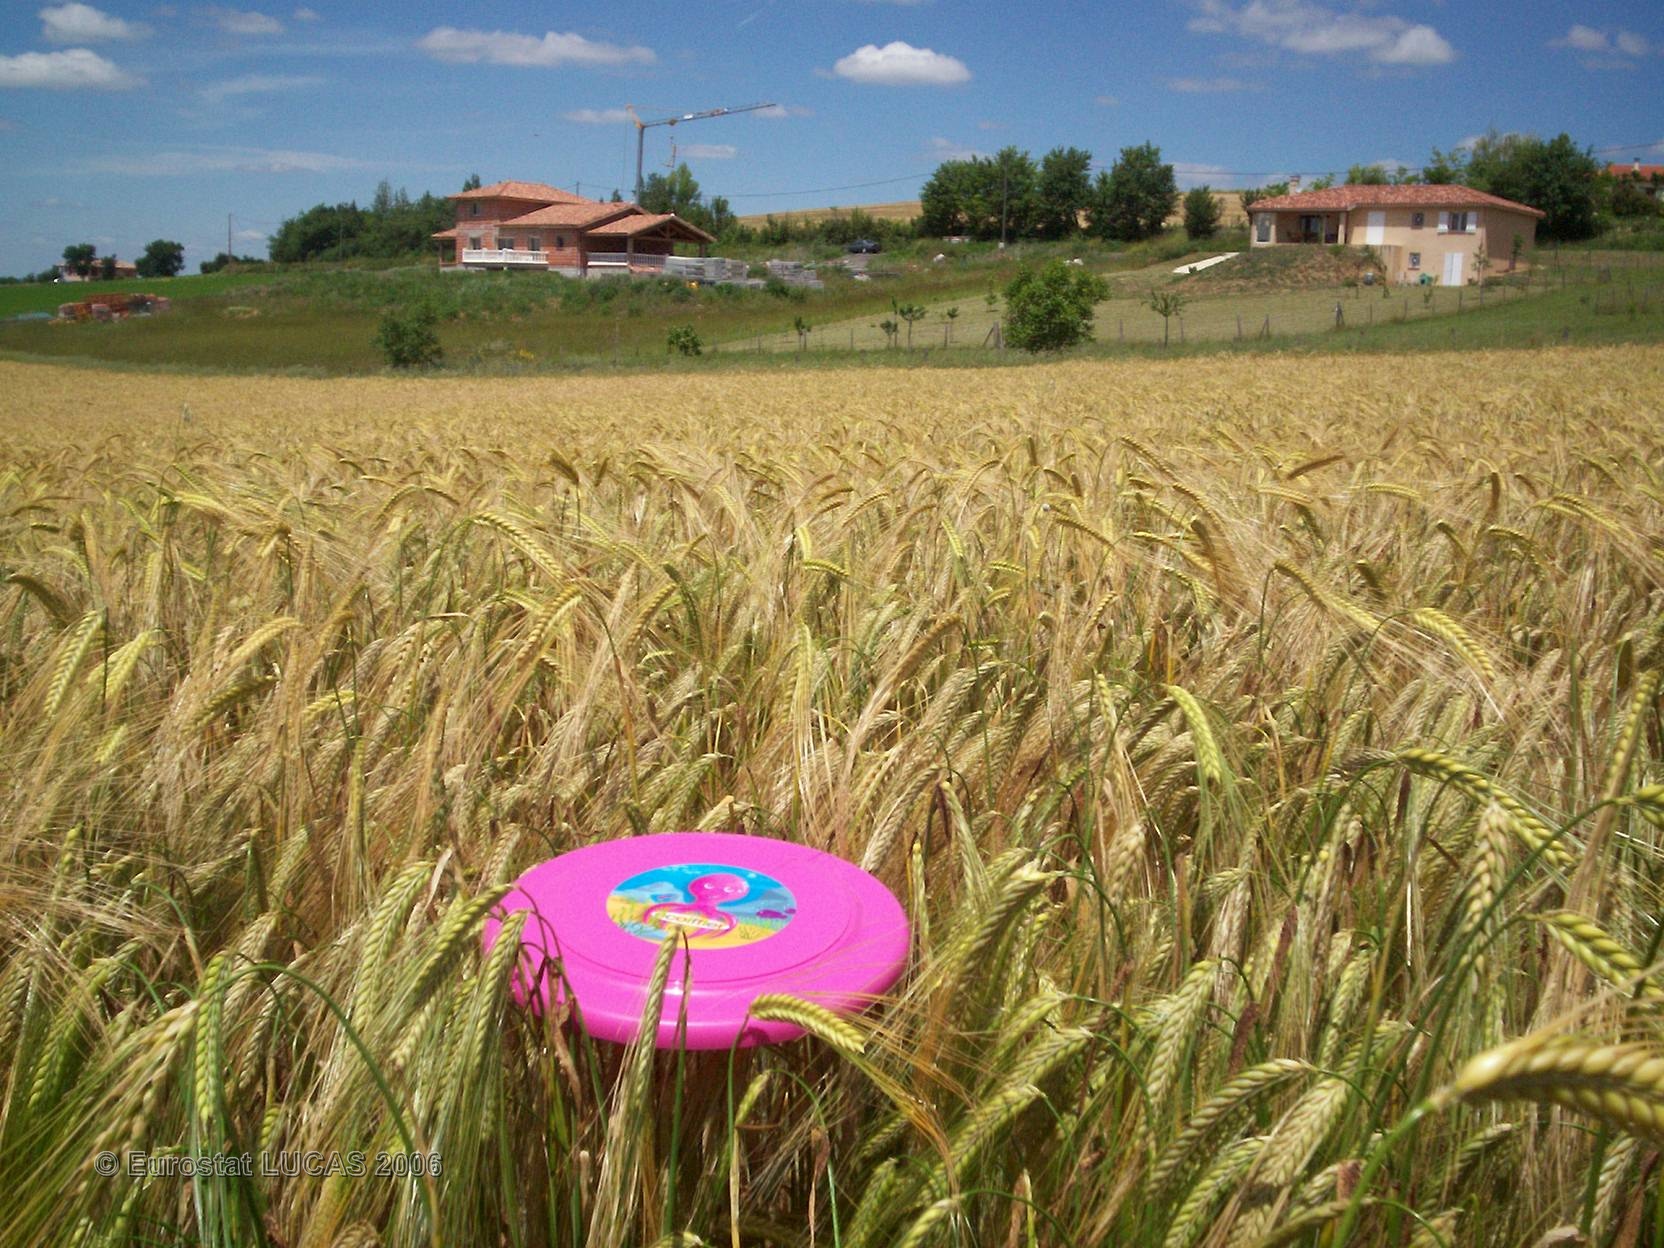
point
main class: Cropland
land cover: Barley
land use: Agriculture (excluding fallow land and kitchen gardens)
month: May
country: FR
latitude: 43.4681
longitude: 0.9900
